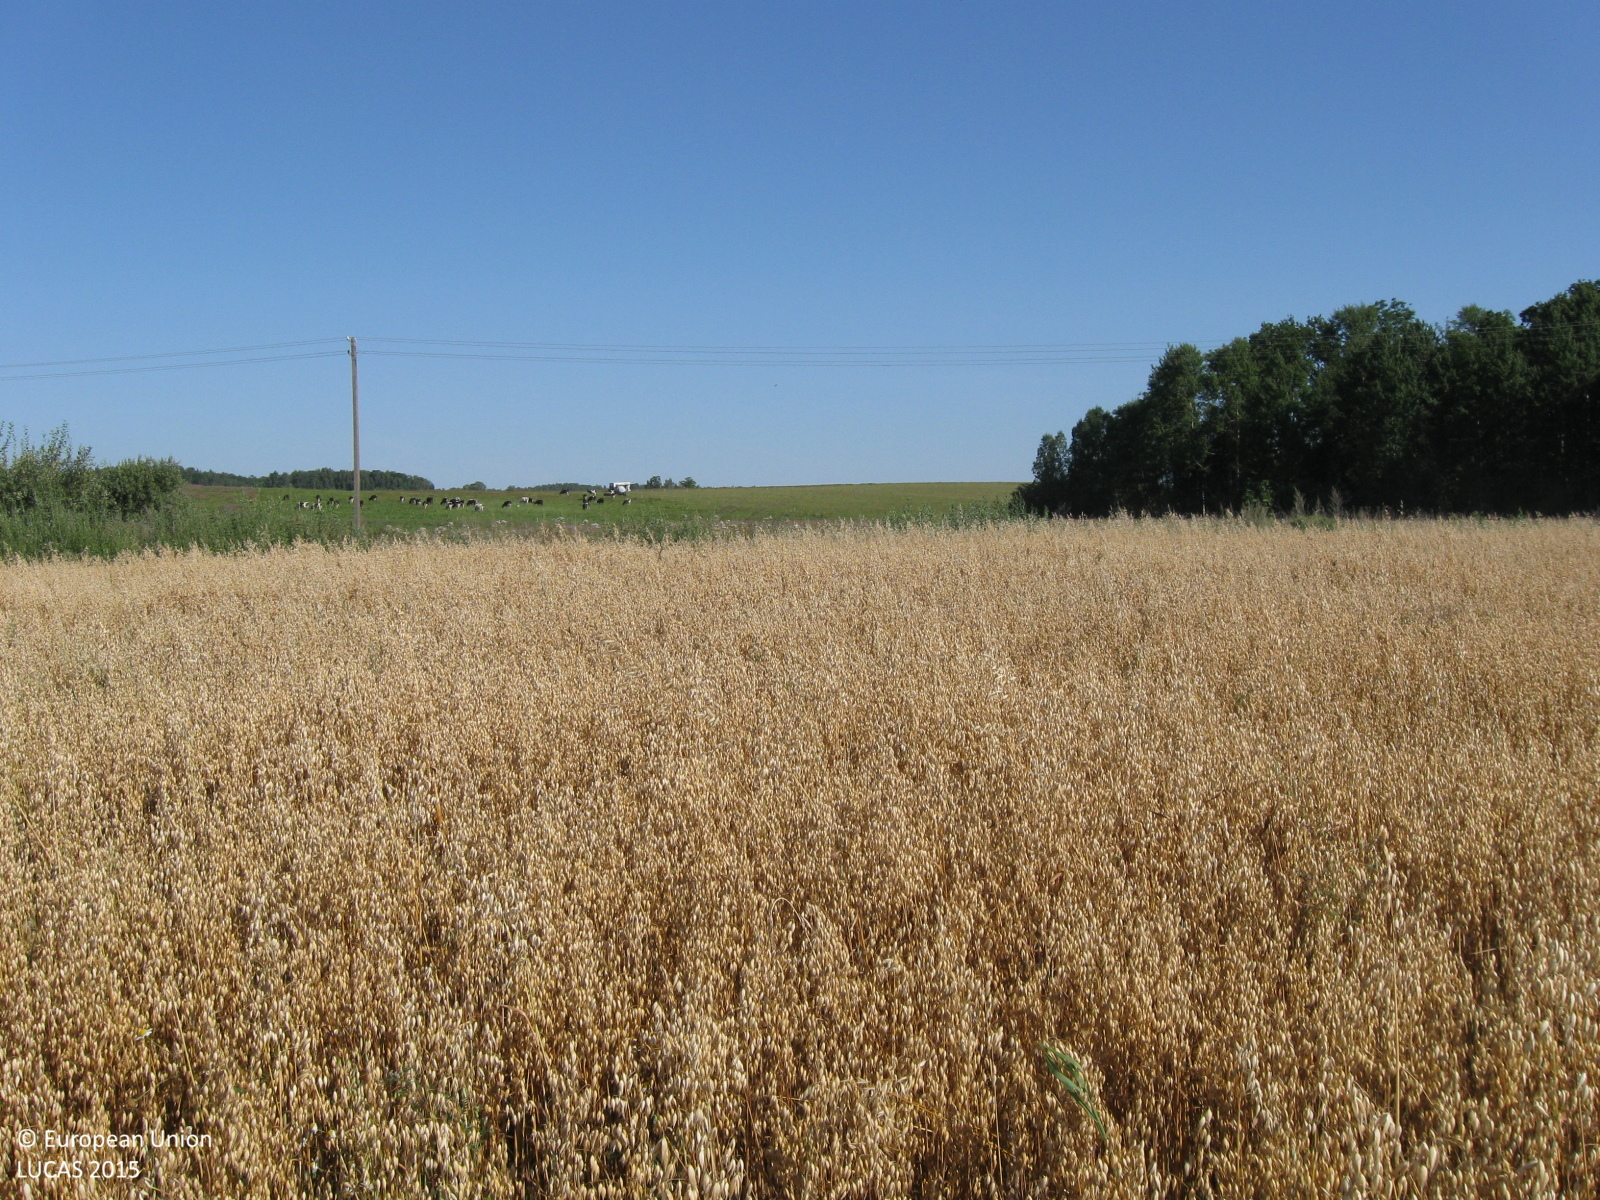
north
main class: Cropland
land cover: Oats
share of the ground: > 75 %
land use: Agriculture (excluding fallow land and kitchen gardens)
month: August
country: LT
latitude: 55.4104
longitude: 22.4917
